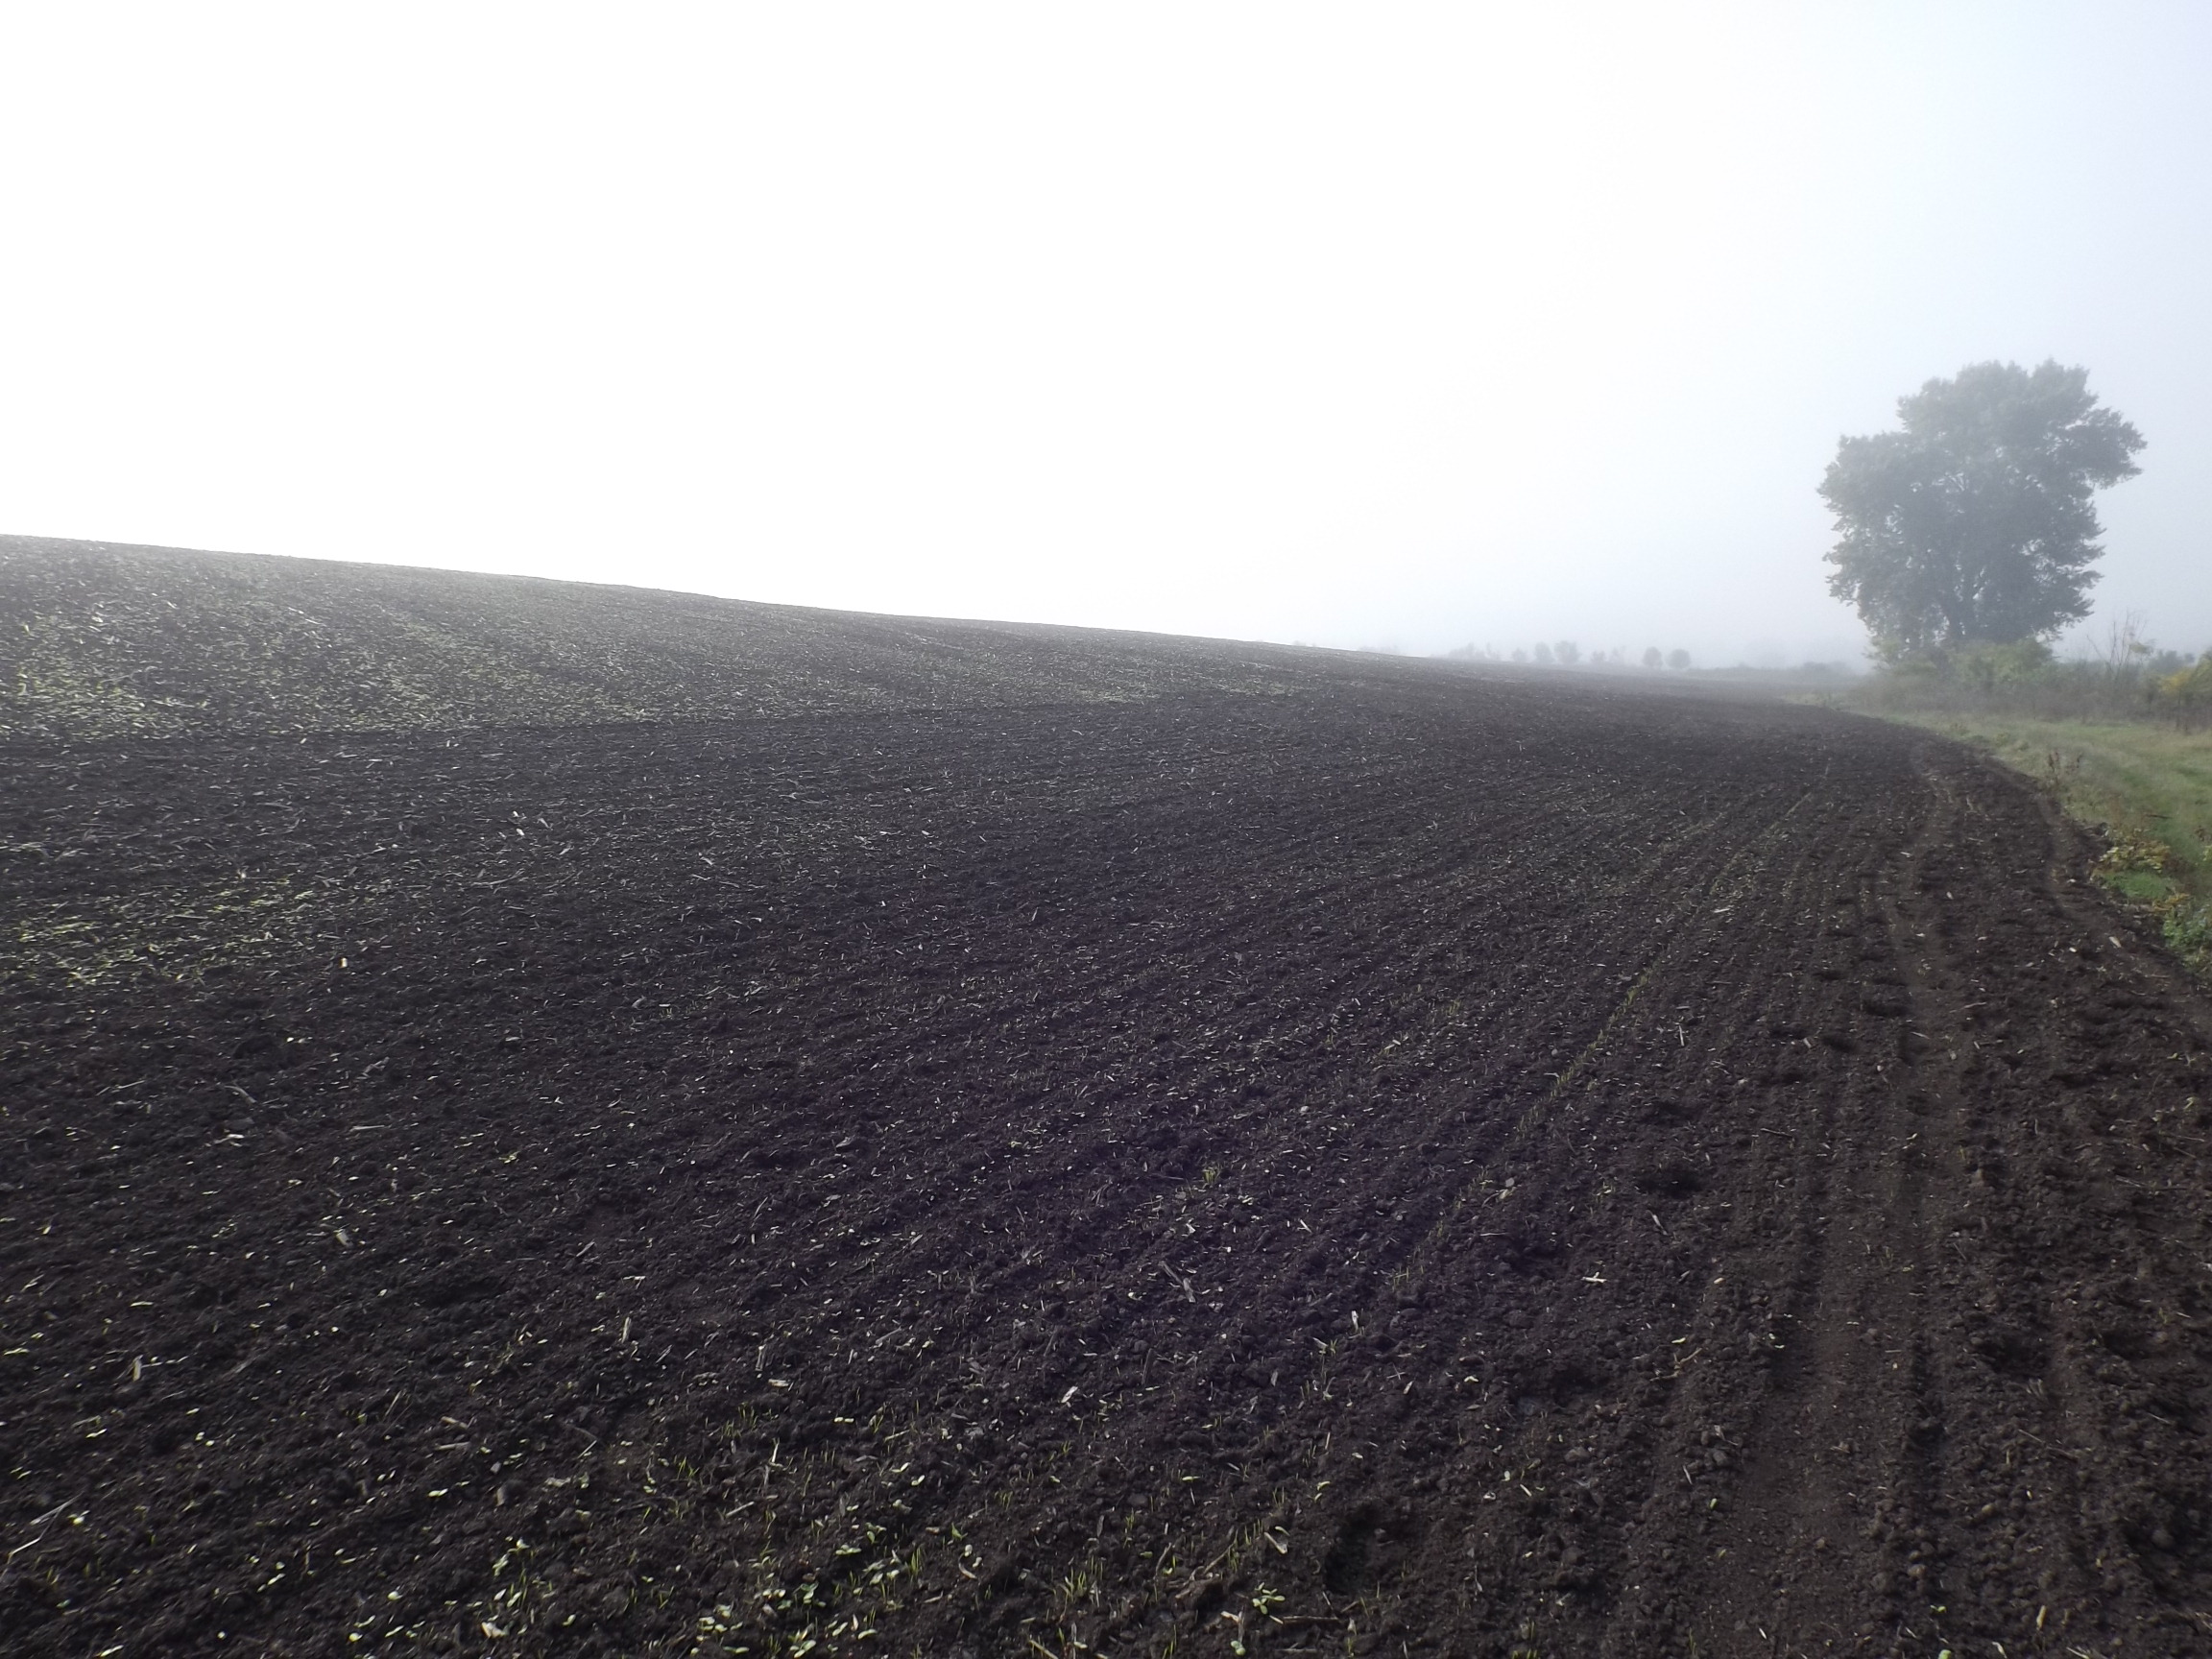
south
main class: Cropland
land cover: Sunflower
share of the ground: < 10 %
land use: Agriculture (excluding fallow land and kitchen gardens)
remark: Harvested field
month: October
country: BG
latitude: 43.1639
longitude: 27.2784
